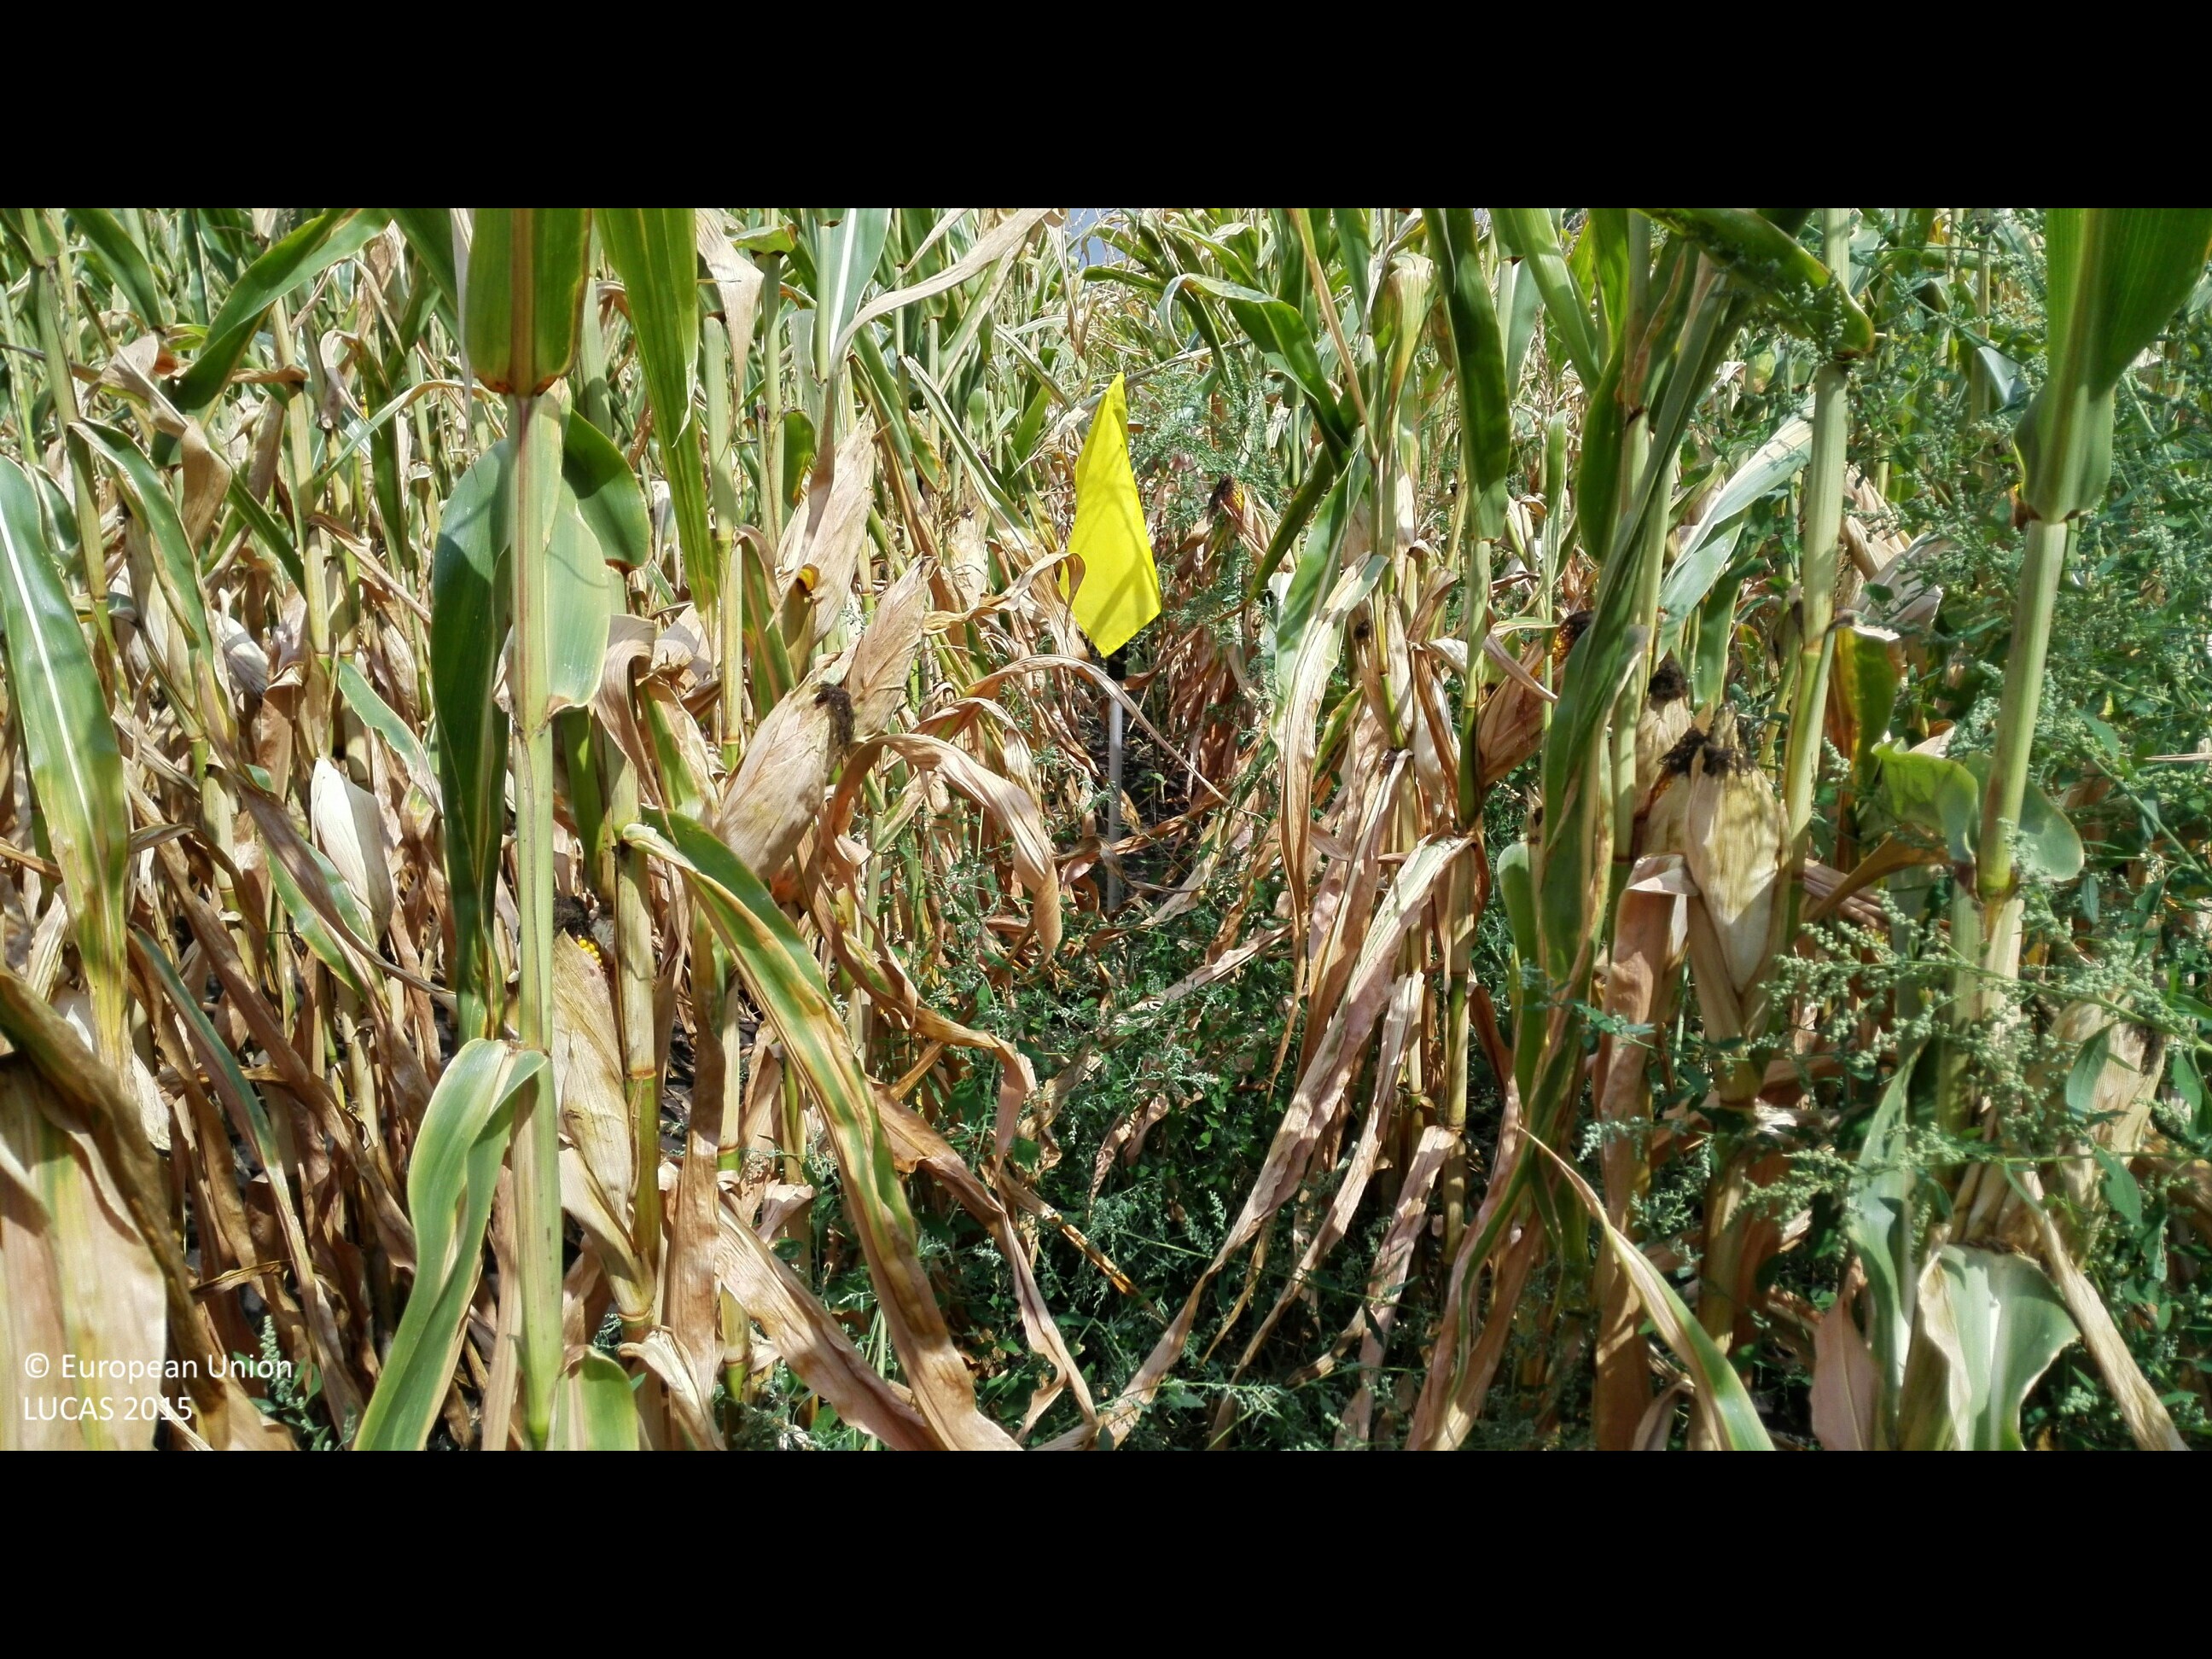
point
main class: Cropland
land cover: Maize
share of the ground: > 75 %
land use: Agriculture (excluding fallow land and kitchen gardens)
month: August
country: HU
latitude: 47.3692
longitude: 21.6310
